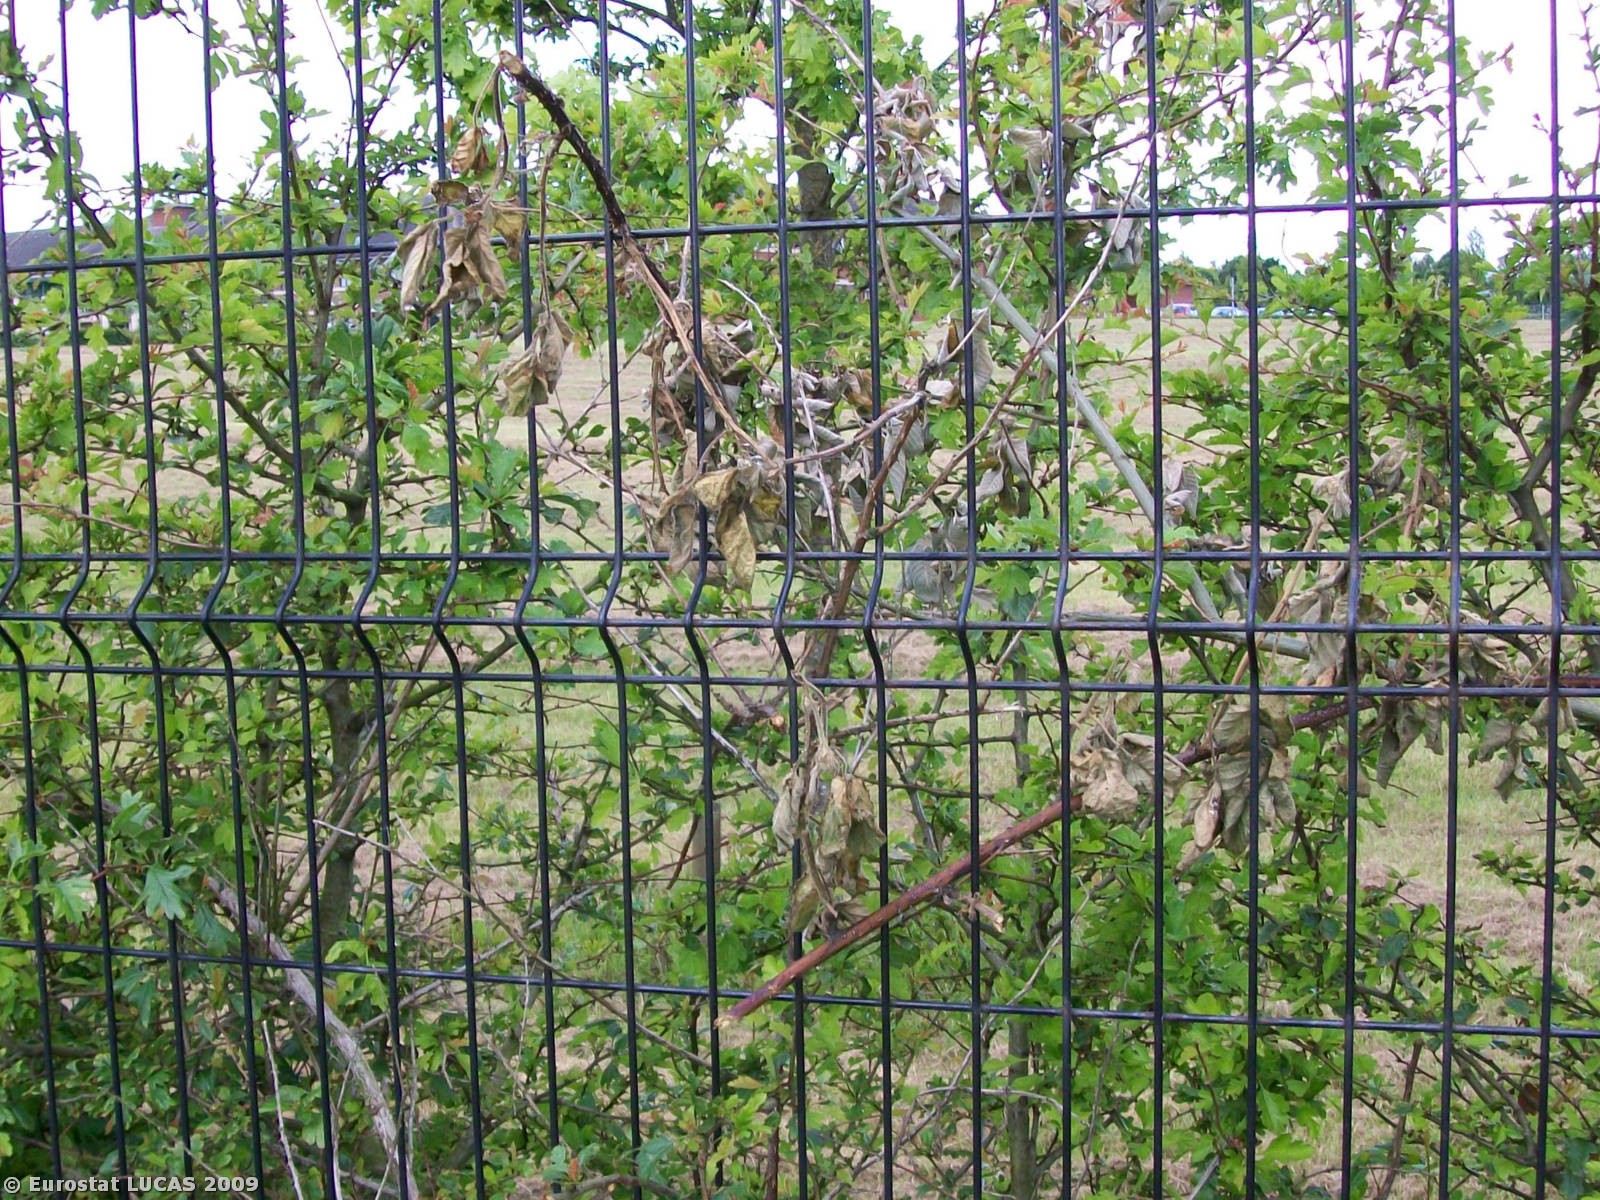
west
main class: Grassland
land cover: Grassland without tree/shrub cover
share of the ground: > 75 %
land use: Amenities, museums, leisure
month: June
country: GB
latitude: 55.0382
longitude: -7.2811
